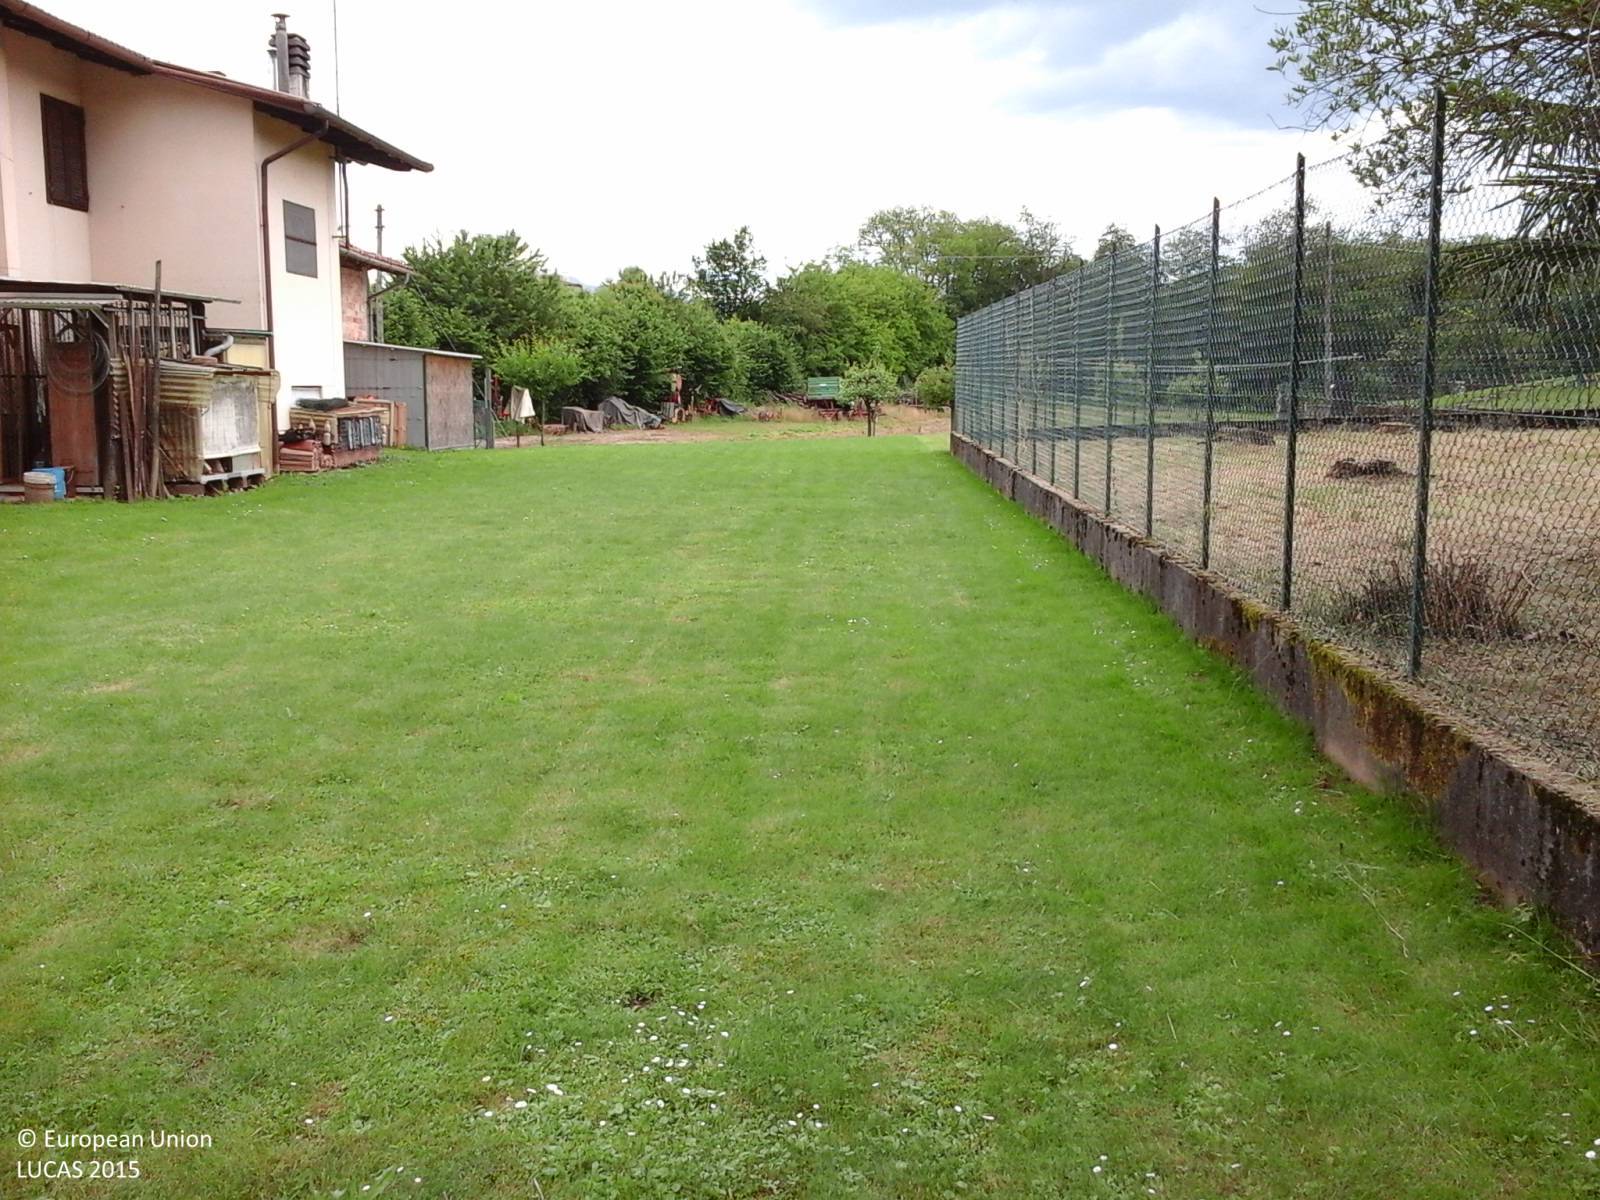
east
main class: Grassland
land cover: Grassland with sparse tree/shrub cover
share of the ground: > 75 %
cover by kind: herbaceous plants 90 %, broadleaved forest trees 5 %, shrubs 5 %
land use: Residential
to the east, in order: Grassland with sparse tree/shrub cover; Artificial constructions in urban areas; Other bare soil; Grass margins; Broadleaved woodland; Grassland without tree/shrub cover; Fences; Grassland without tree/shrub cover; Fences; Grass margins; Maize
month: May
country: IT
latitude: 46.1765
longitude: 13.2220
